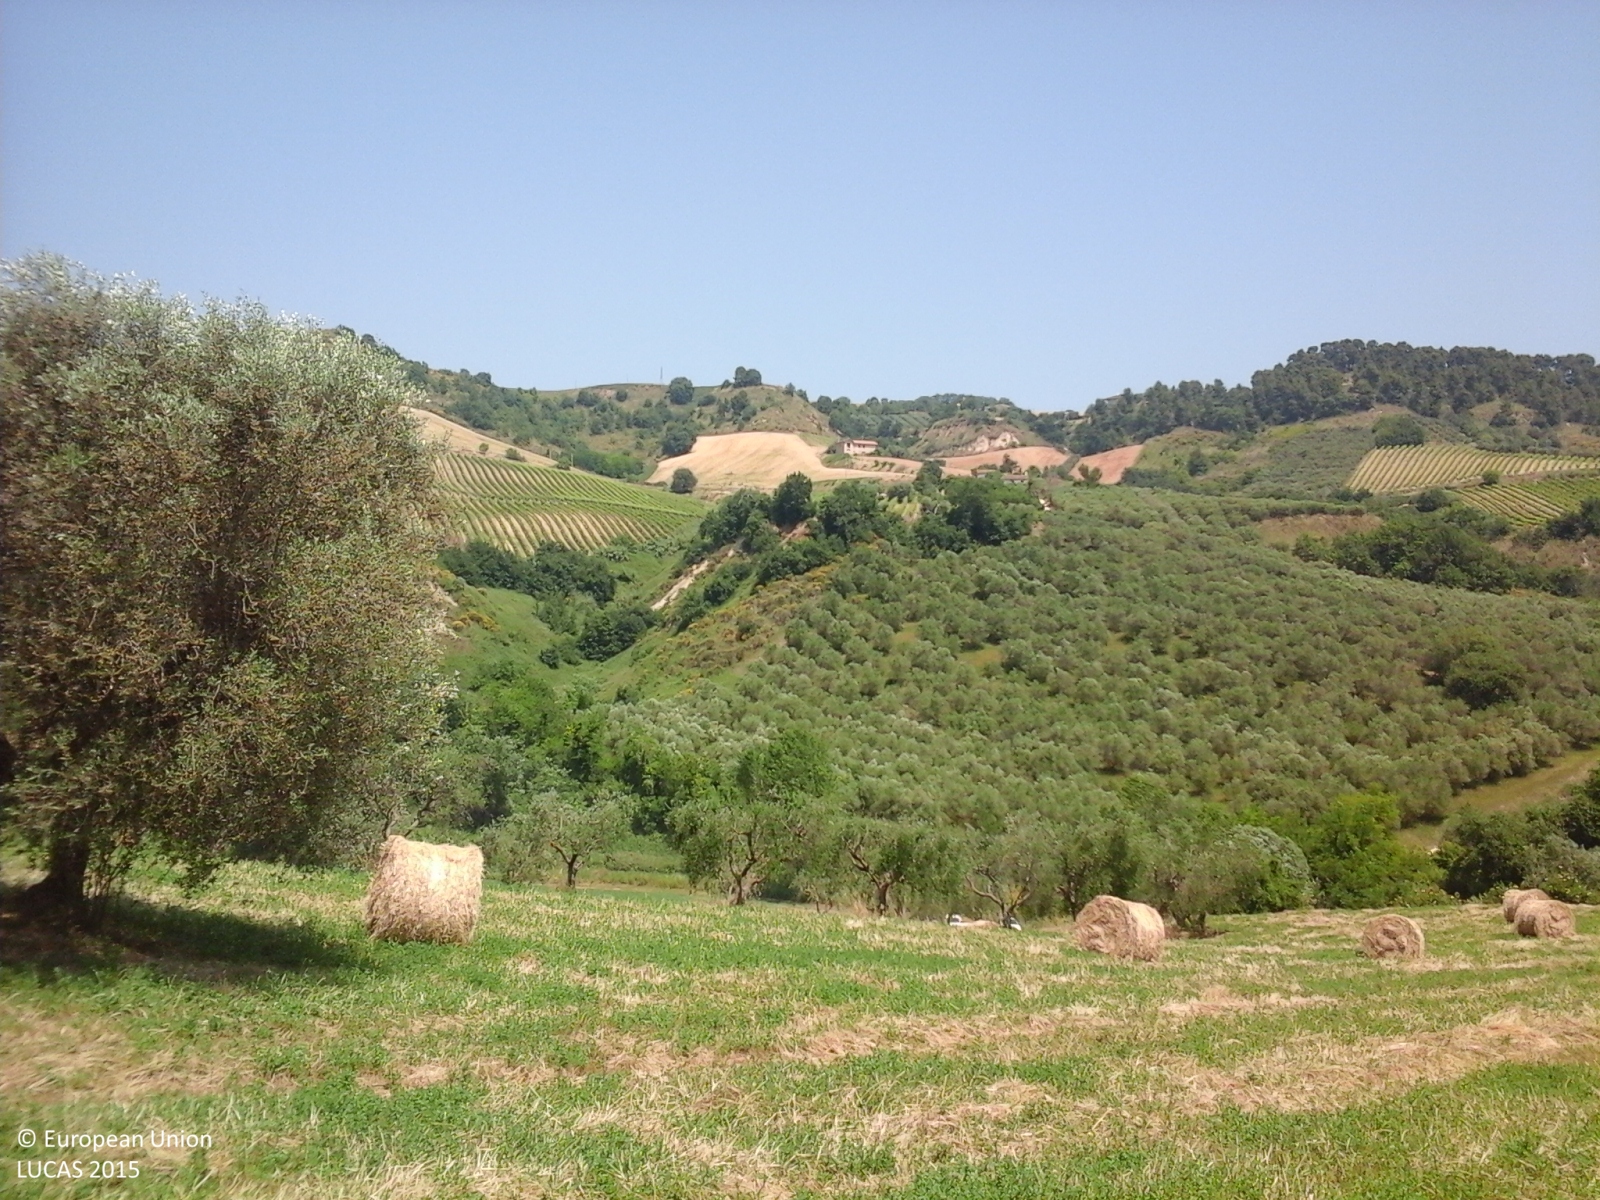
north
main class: Cropland
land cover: Olive groves
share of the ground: < 10 %
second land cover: Lucerne
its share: > 75 %
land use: Agriculture (excluding fallow land and kitchen gardens)
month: June
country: IT
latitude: 42.9244
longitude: 13.8488
